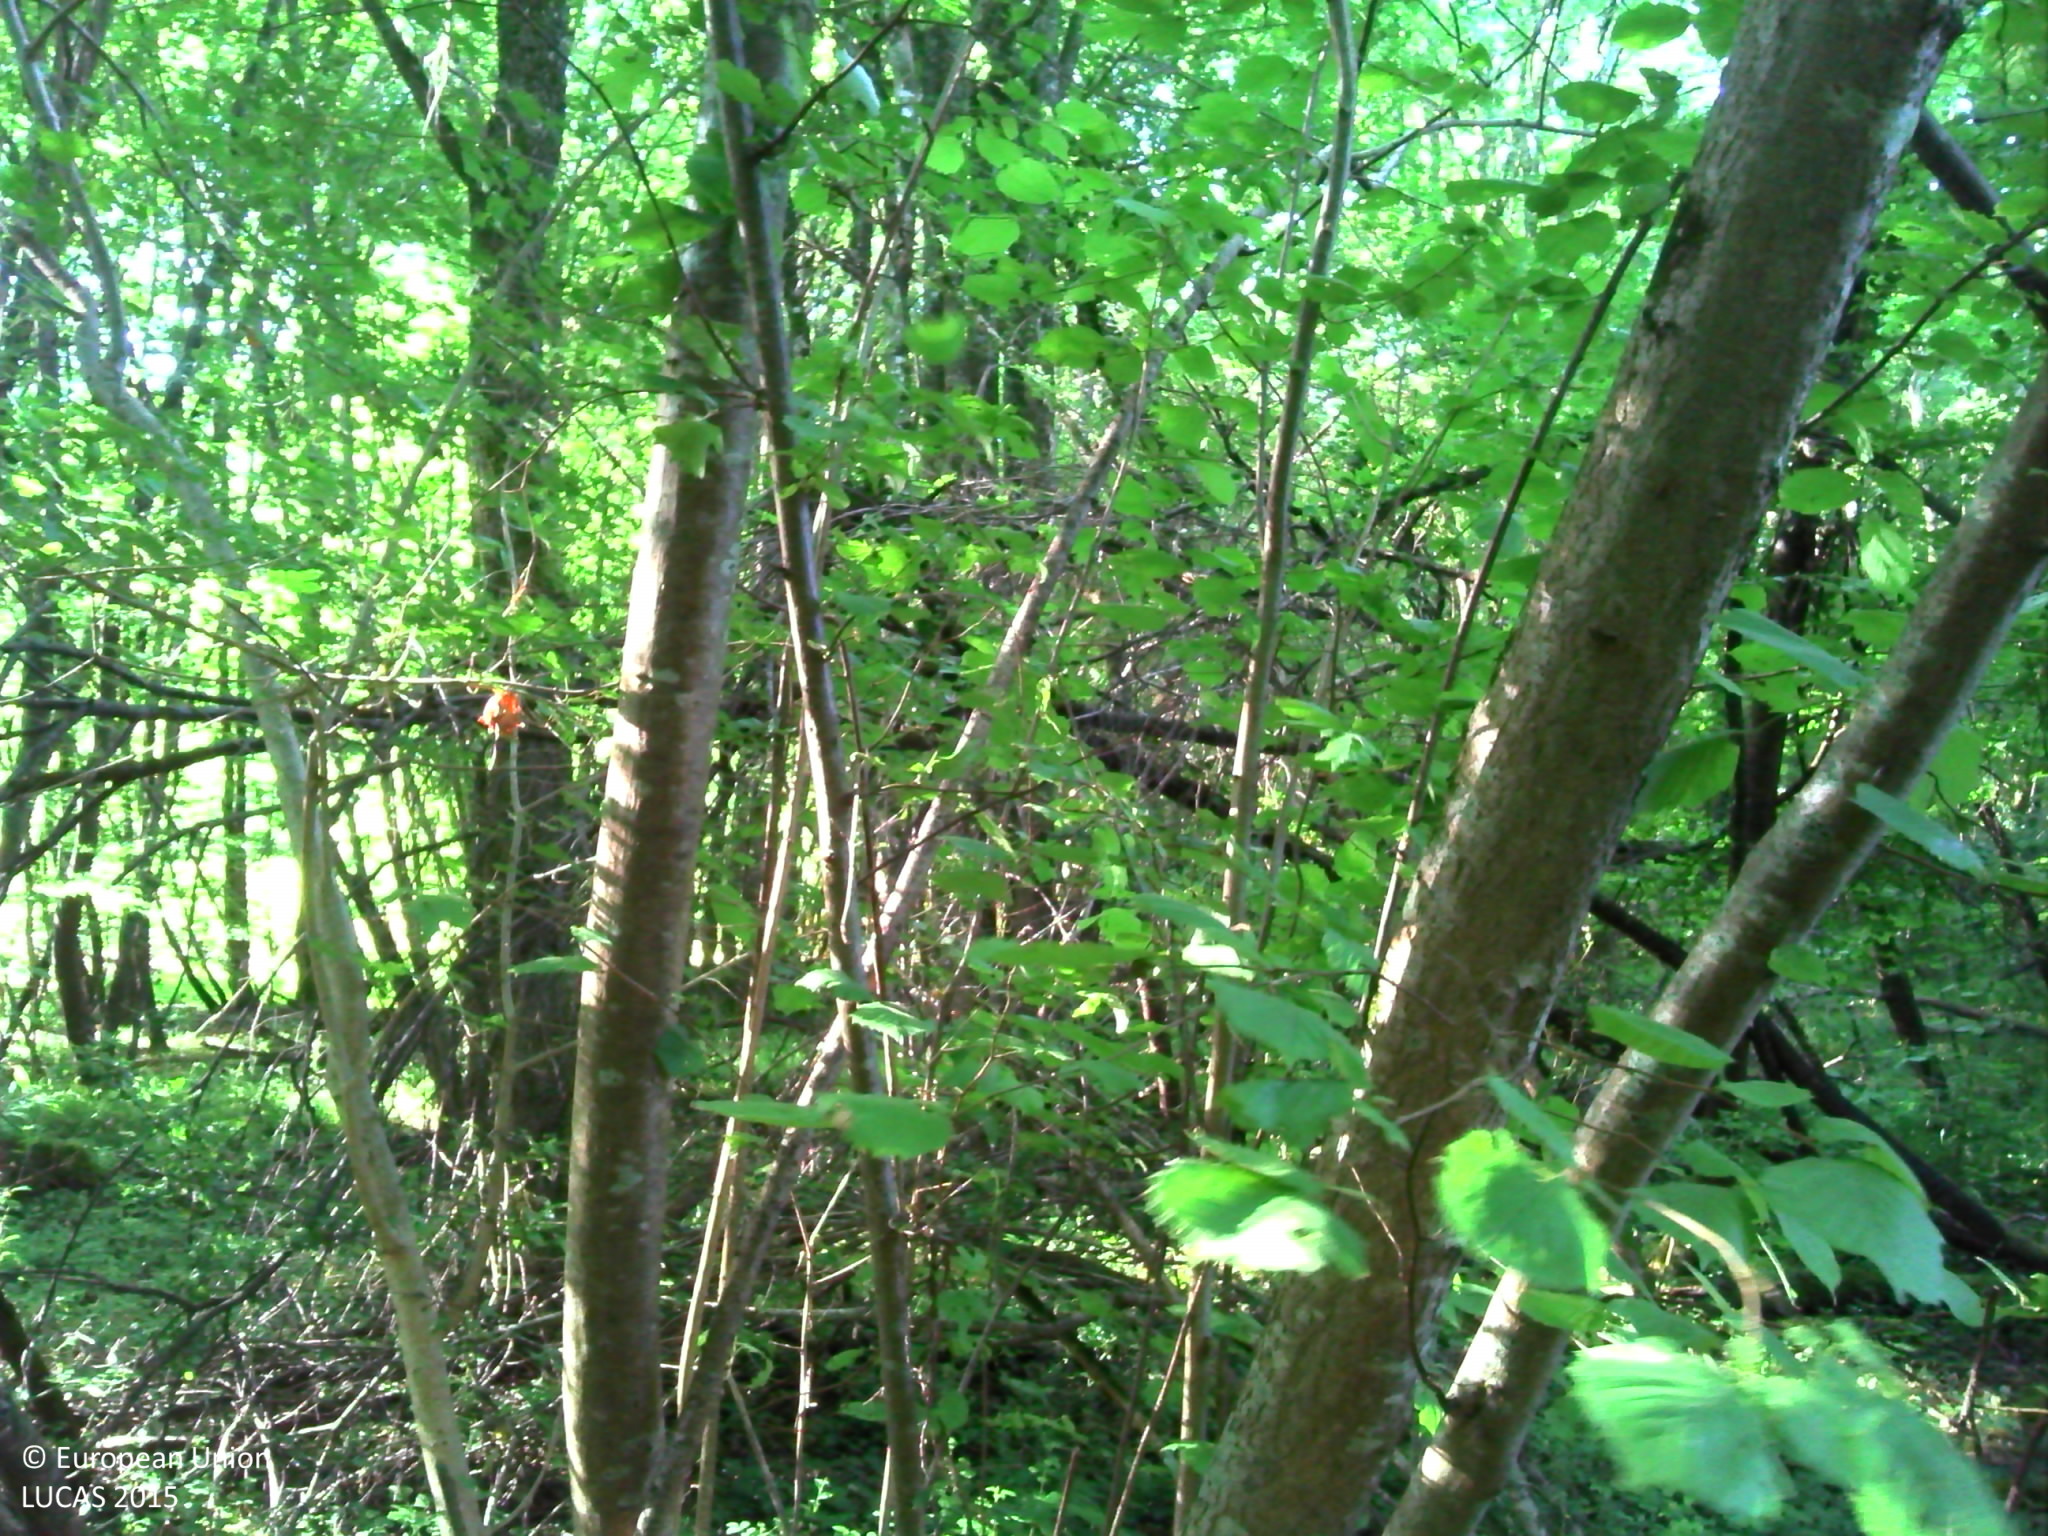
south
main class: Woodland
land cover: Broadleaved woodland
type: beech forest
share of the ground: > 75 %
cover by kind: broadleaved forest trees 90 %, herbaceous plants 10 %
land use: Forestry
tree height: > 5 m
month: June
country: FR
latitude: 46.9851
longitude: 2.9352
